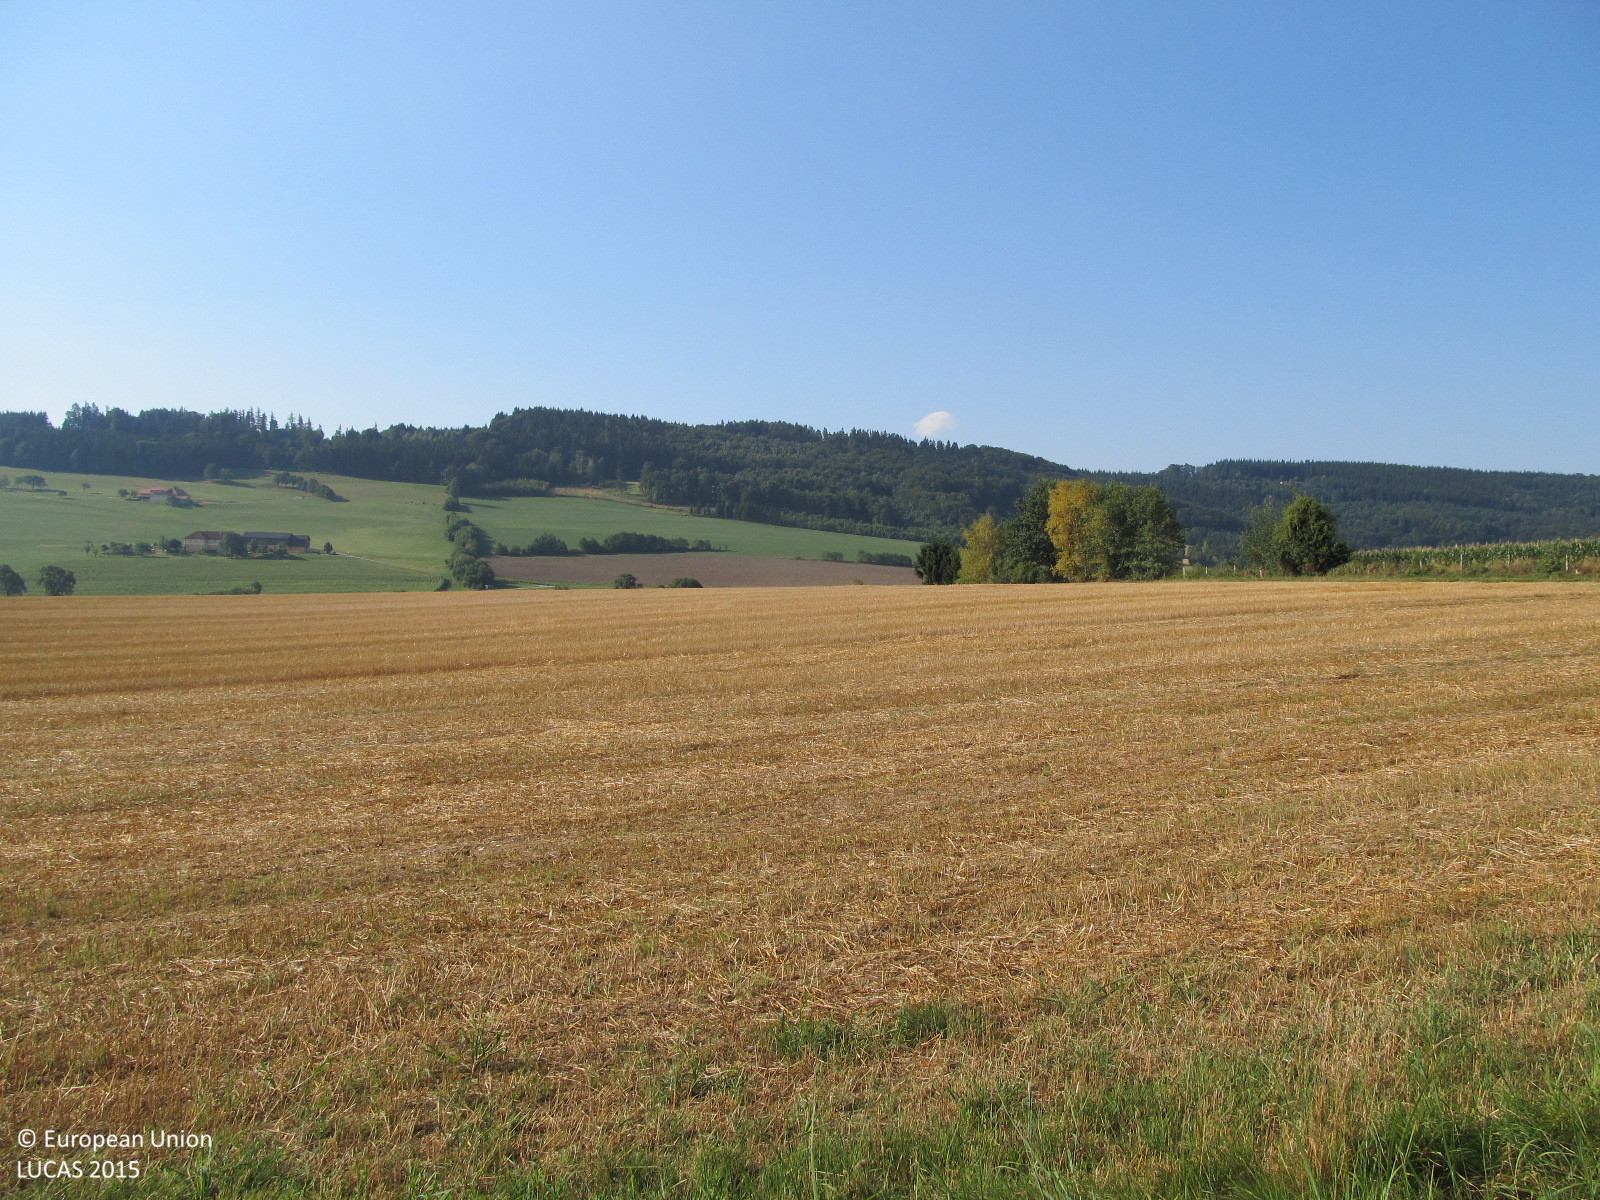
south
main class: Woodland
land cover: Spruce dominated coniferous woodland
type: hemiboreal forest and nemoral coniferous forest and mixed broadleaved-coniferous forest
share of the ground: > 75 %
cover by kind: coniferous forest trees 100 %
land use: Forestry
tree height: > 5 m
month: August
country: AT
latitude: 48.0893
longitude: 15.4394
